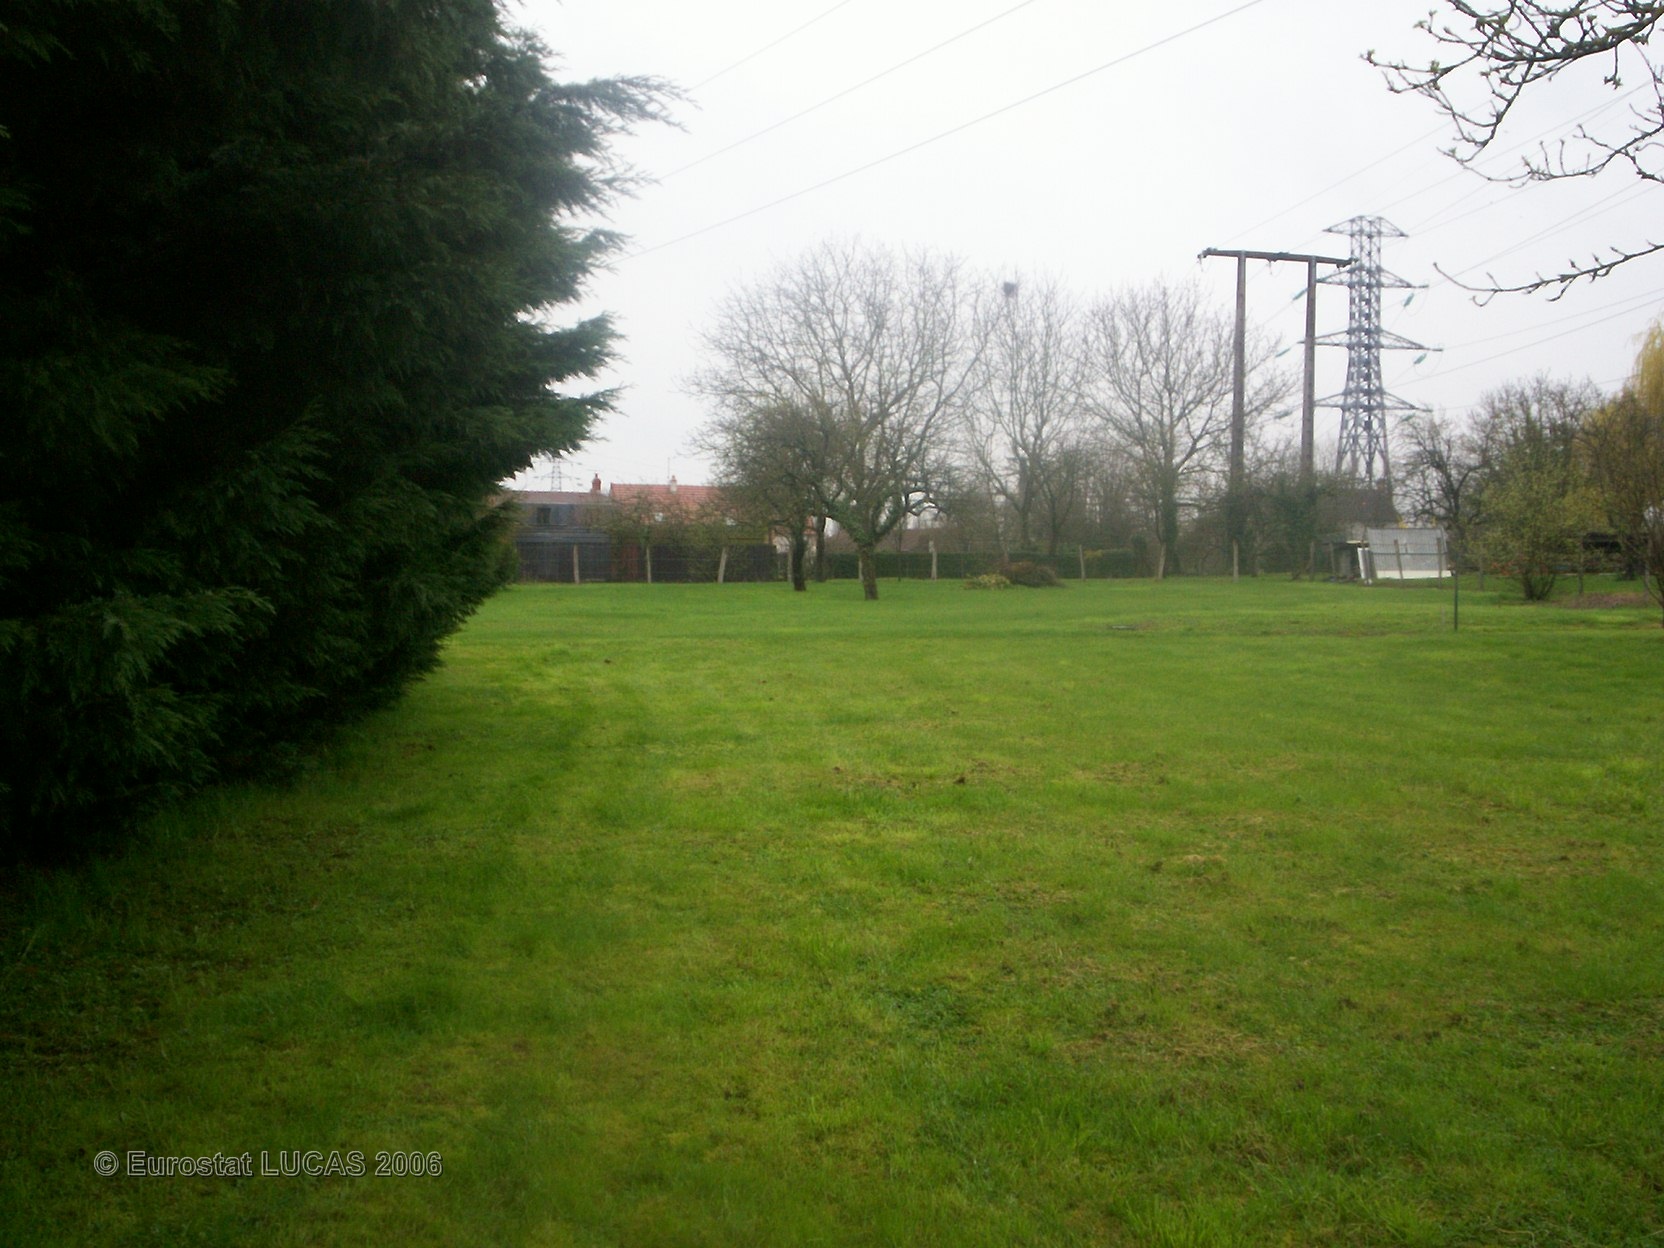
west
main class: Grassland
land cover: Grassland with sparse tree/shrub cover
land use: Residential
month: April
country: FR
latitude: 47.0311
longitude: 3.0876
